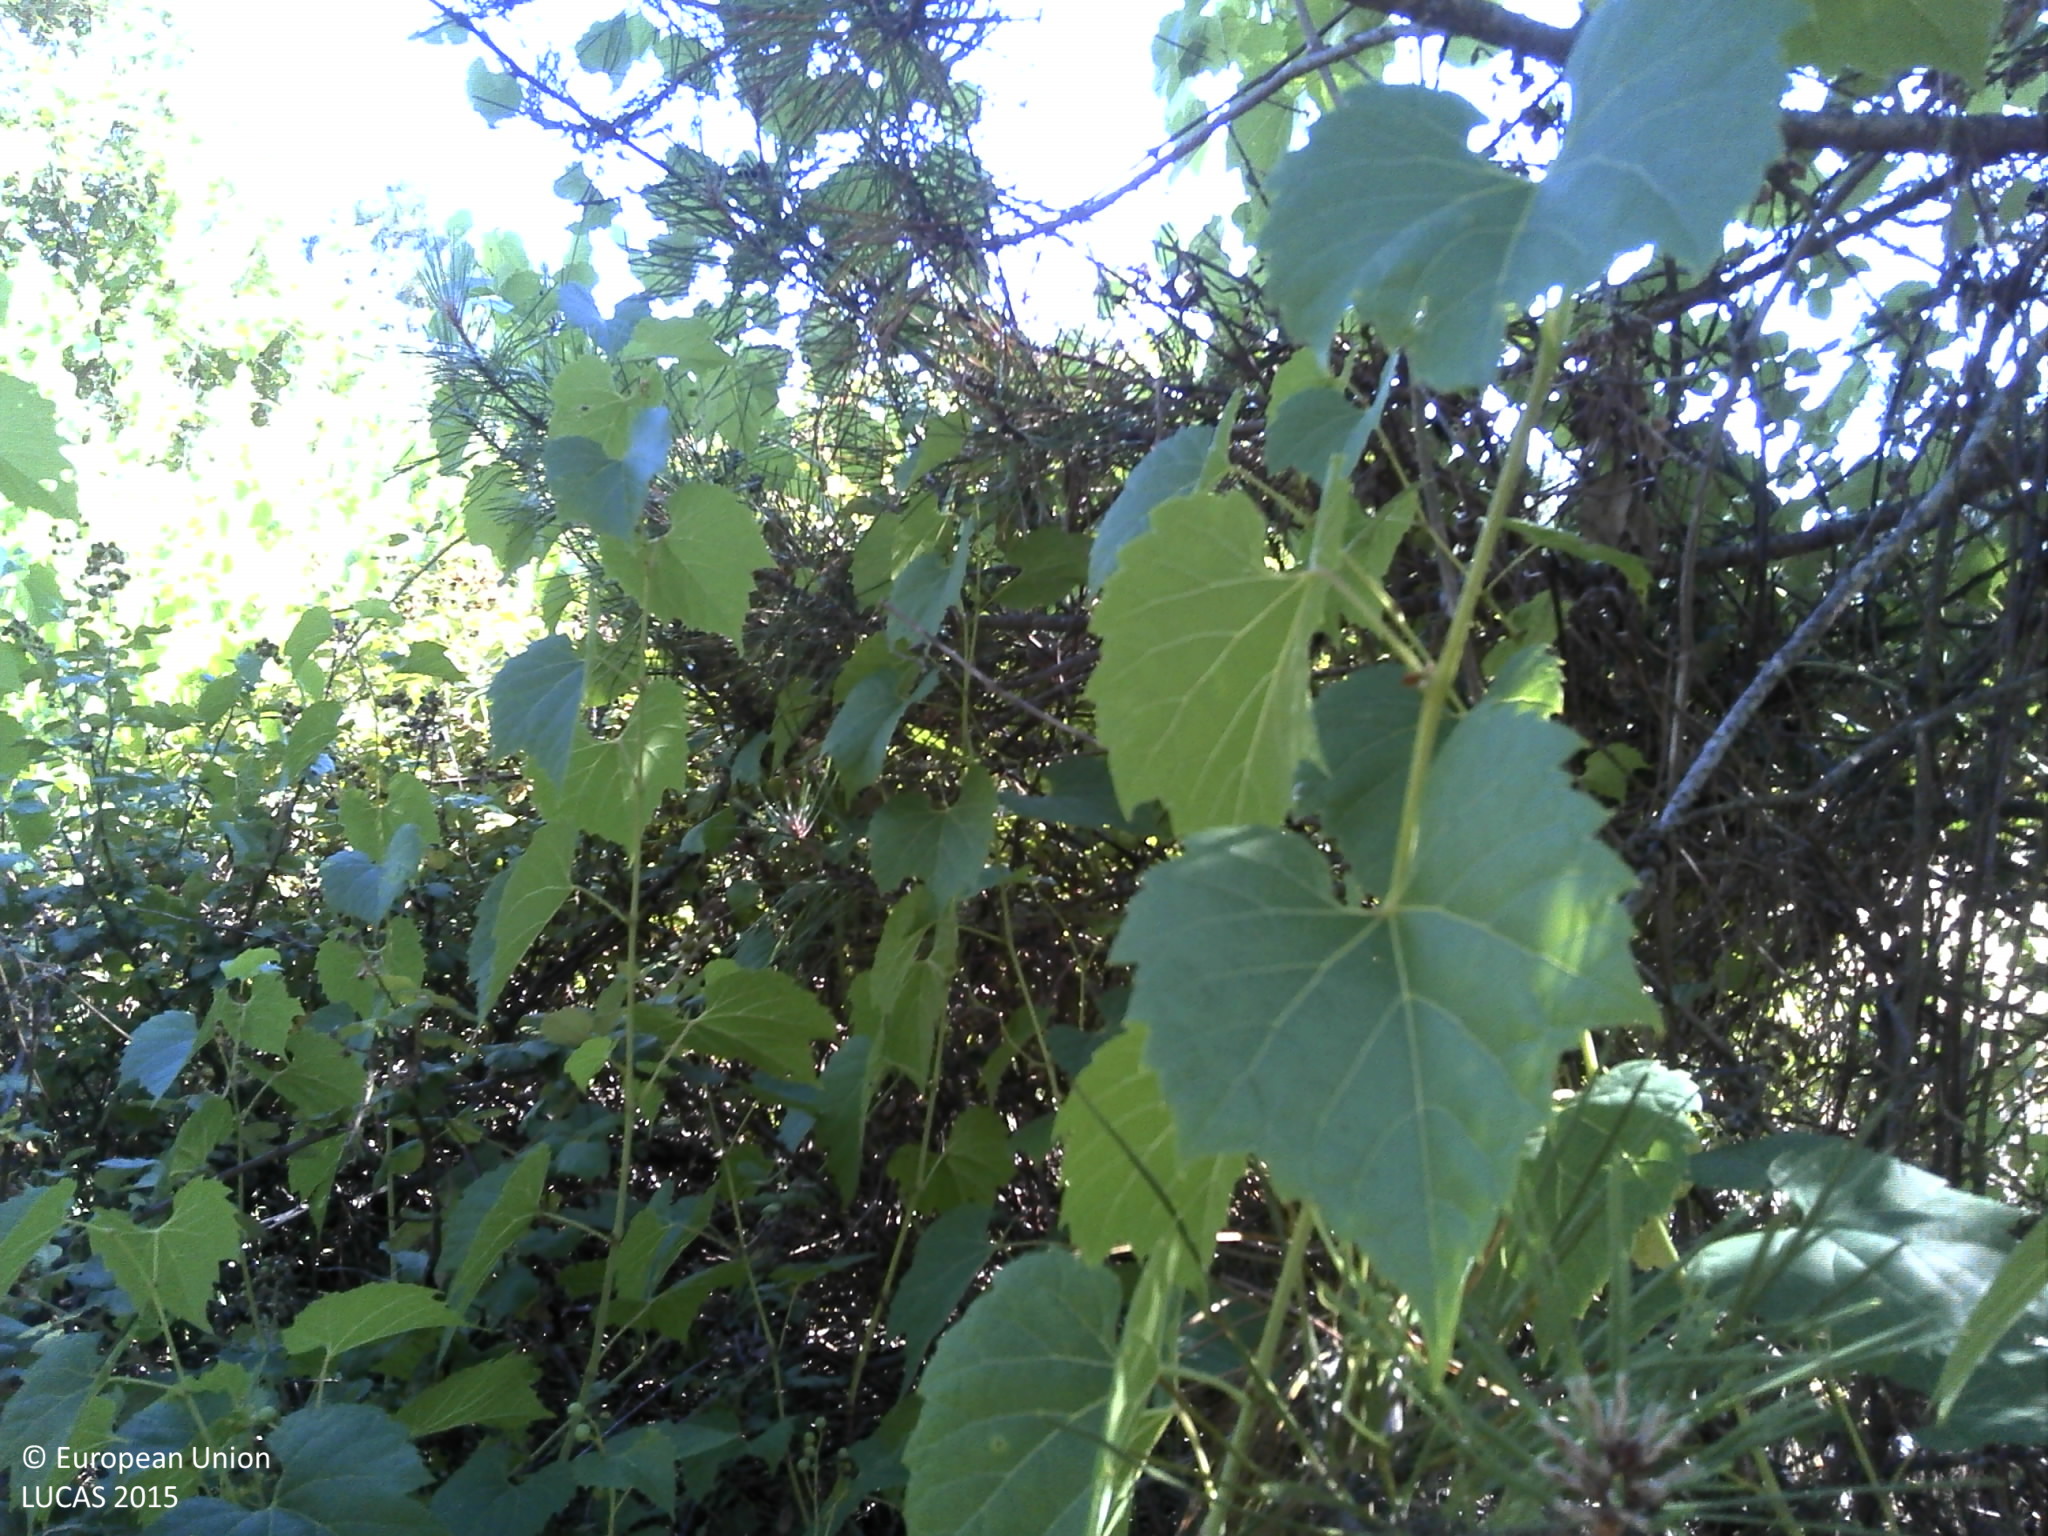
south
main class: Woodland
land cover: Pine dominated coniferous woodland
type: coniferous forest of the mediterranean region
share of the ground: 10 - 25 %
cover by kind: shrubs 50 %, unconsolidated bare surface 35 %, coniferous forest trees 15 %
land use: Forestry
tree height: > 5 m
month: July
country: PT
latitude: 40.7360
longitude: -7.4616
